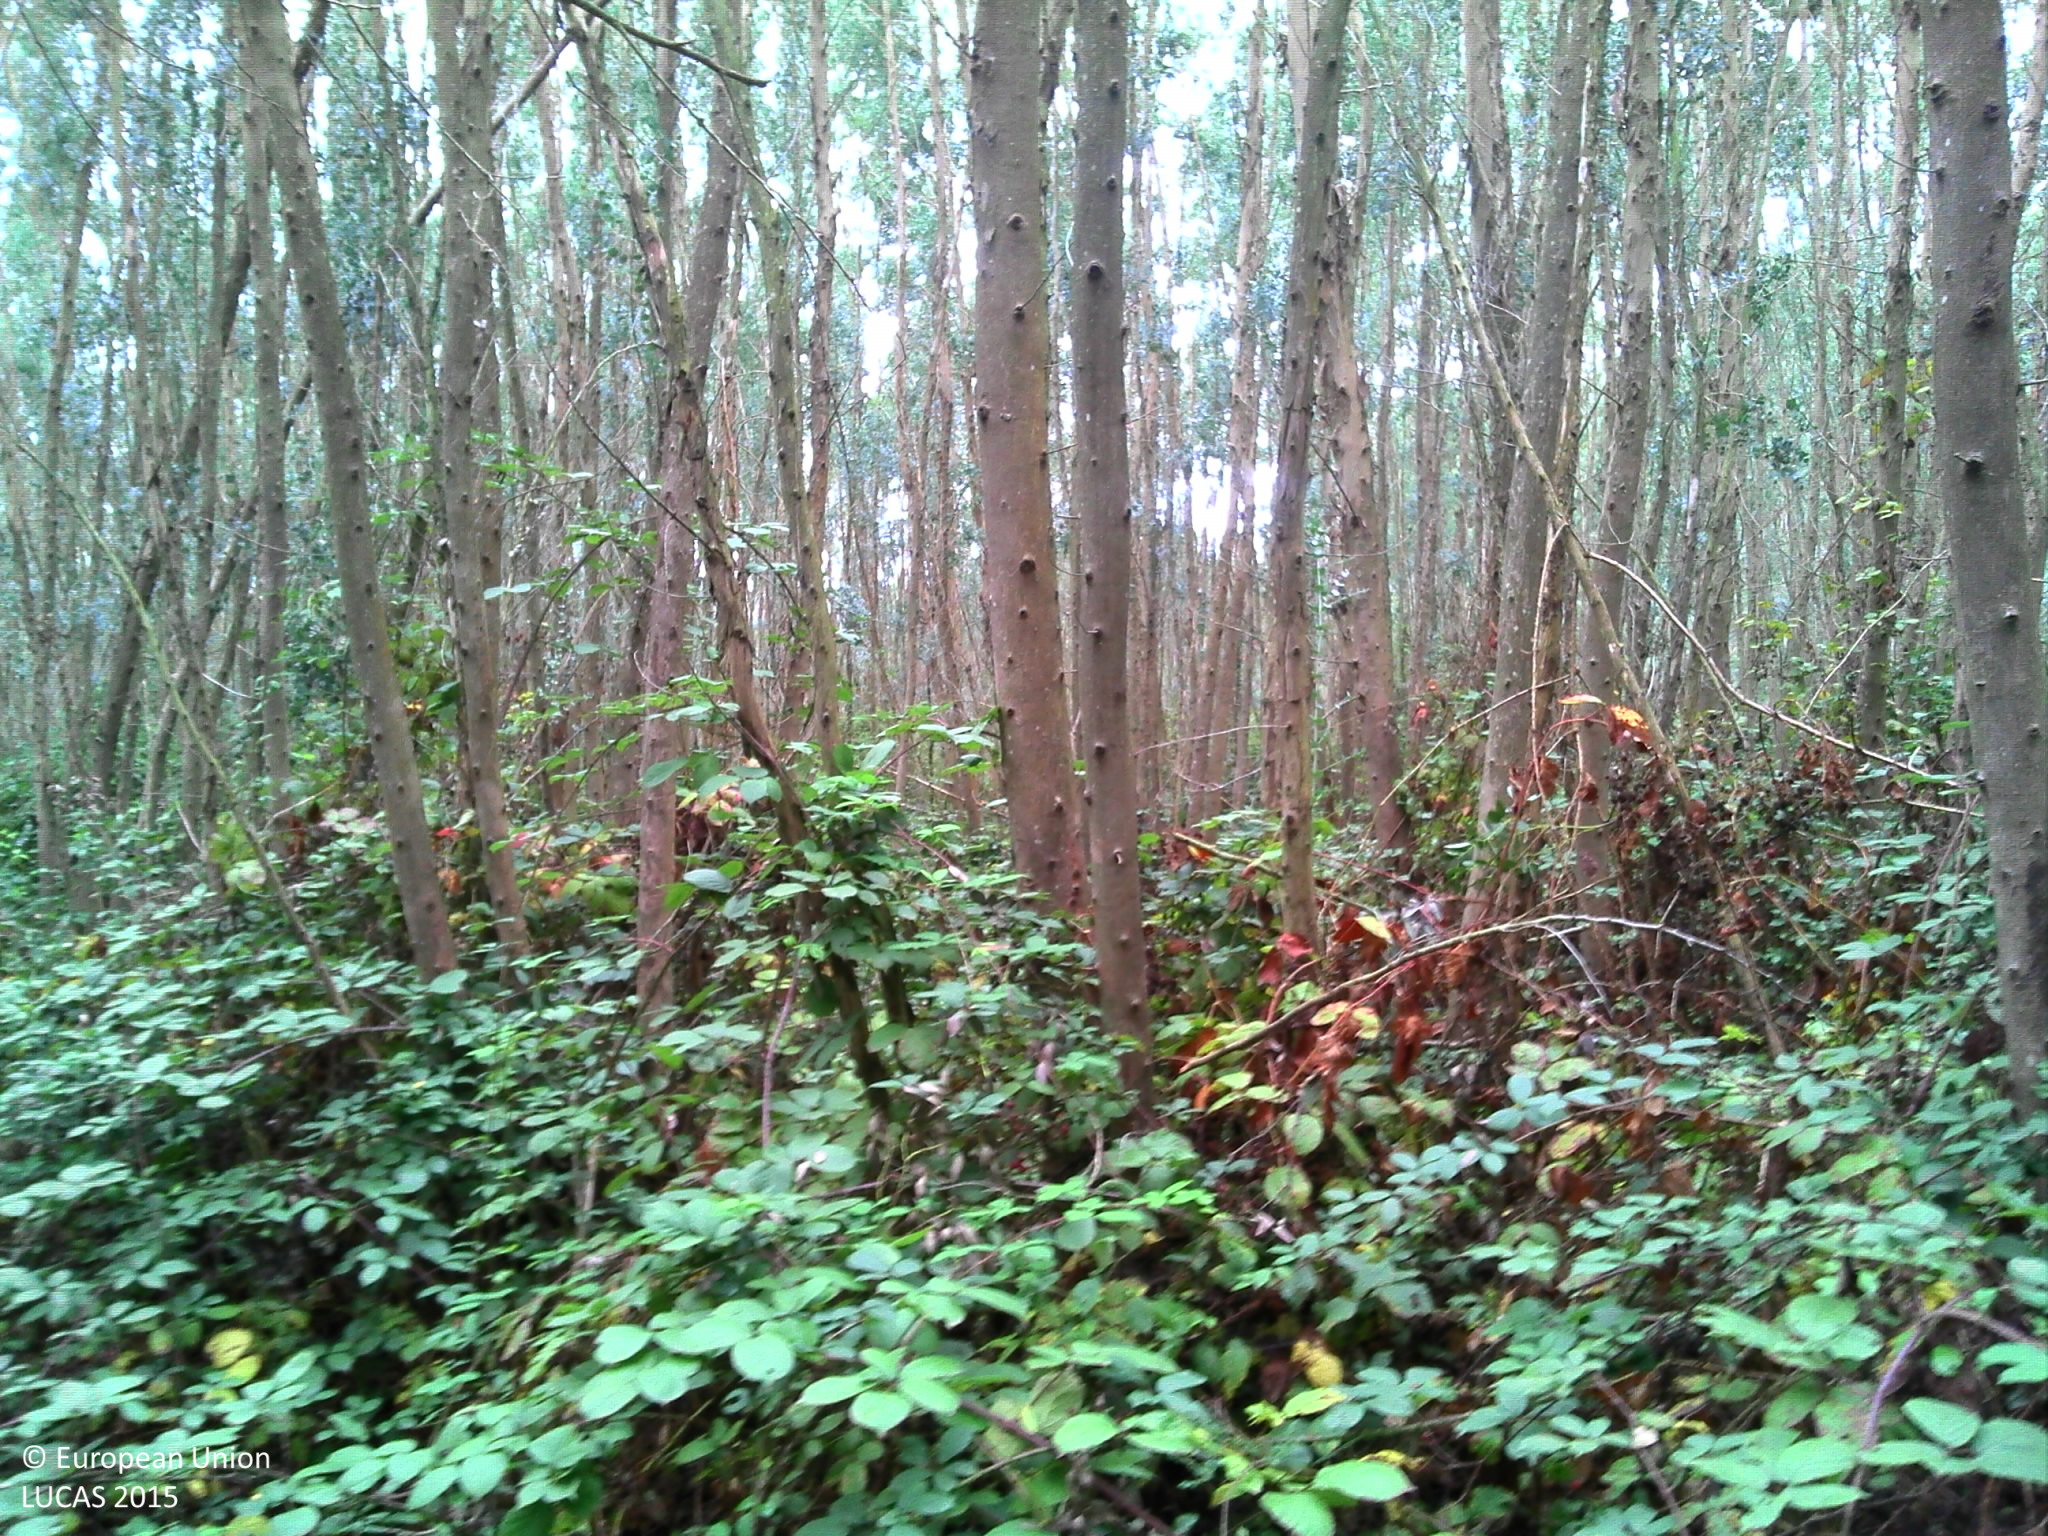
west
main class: Woodland
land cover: Broadleaved woodland
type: exotic forest
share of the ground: 50 - 75 %
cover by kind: broadleaved forest trees 60 %, shrubs 30 %, herbaceous plants 5 %, lichens and mosses 5 %
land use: Forestry
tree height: > 5 m
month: September
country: FR
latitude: 43.3813
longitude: -0.4878
